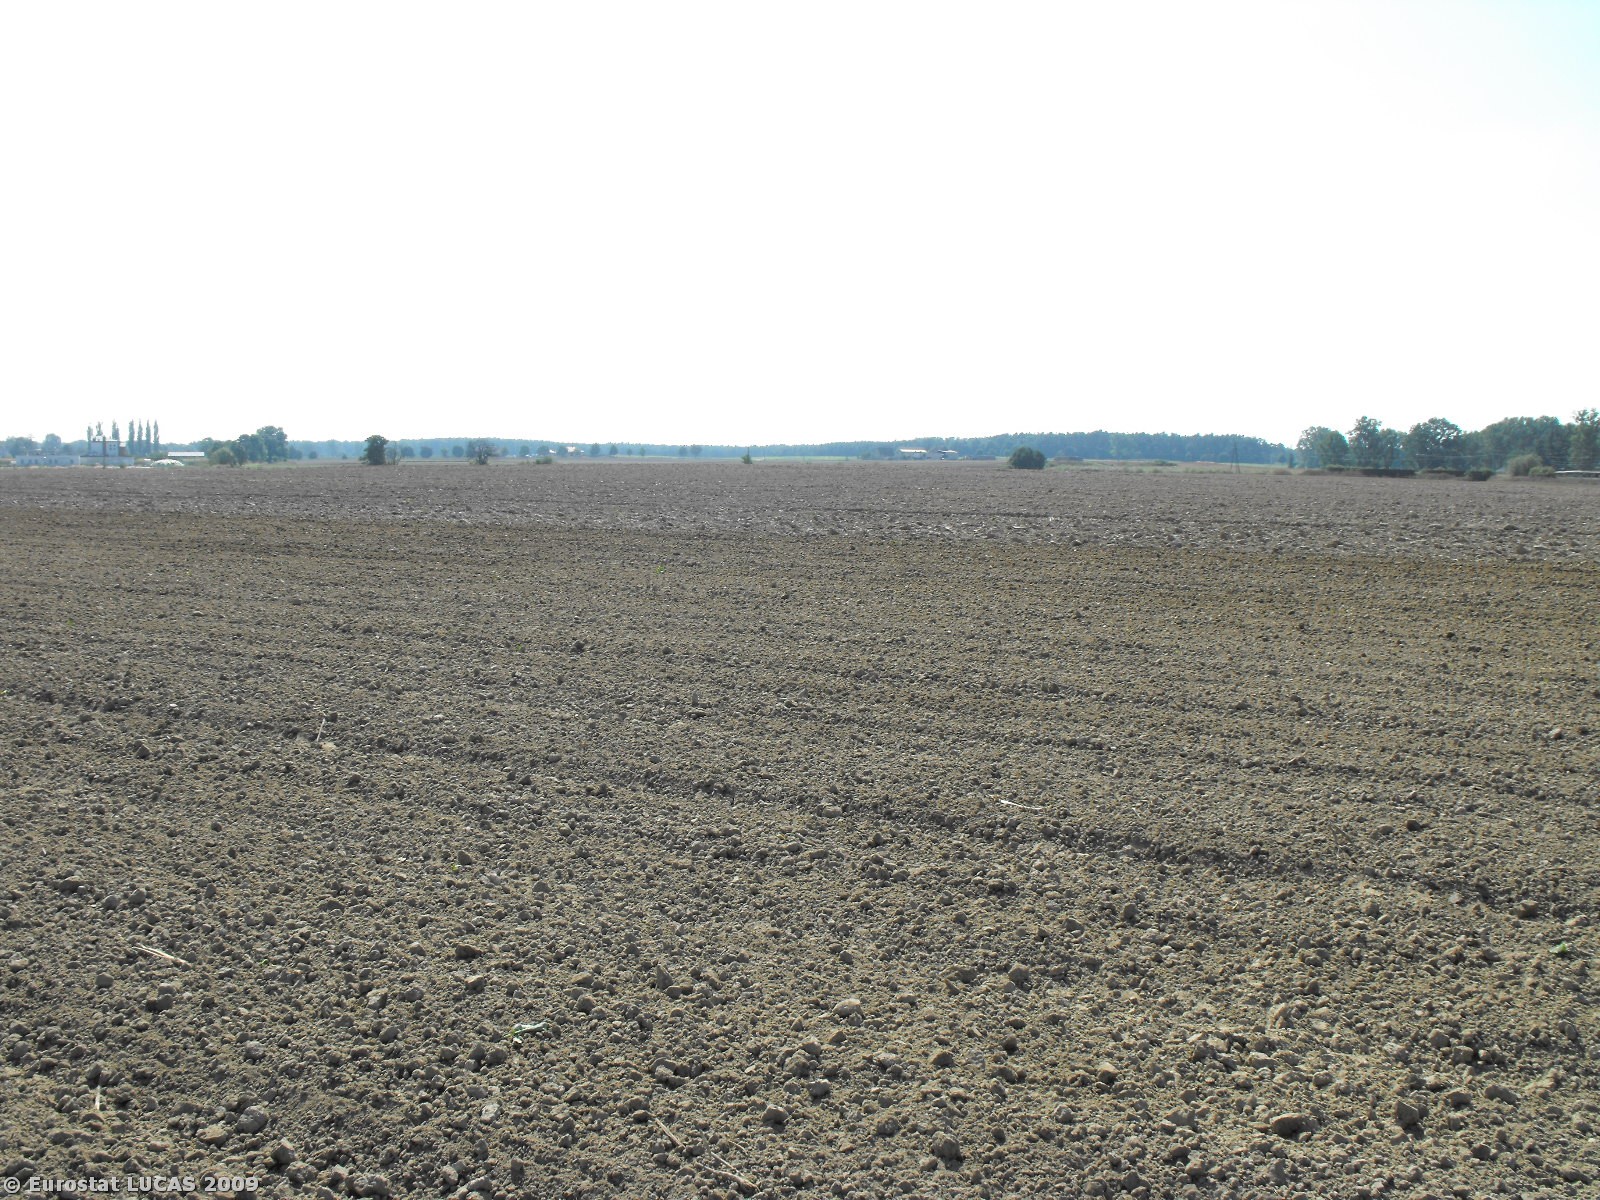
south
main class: Cropland
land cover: Rape and turnip rape
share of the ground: < 10 %
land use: Agriculture (excluding fallow land and kitchen gardens)
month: September
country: PL
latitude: 52.3720
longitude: 16.3079
